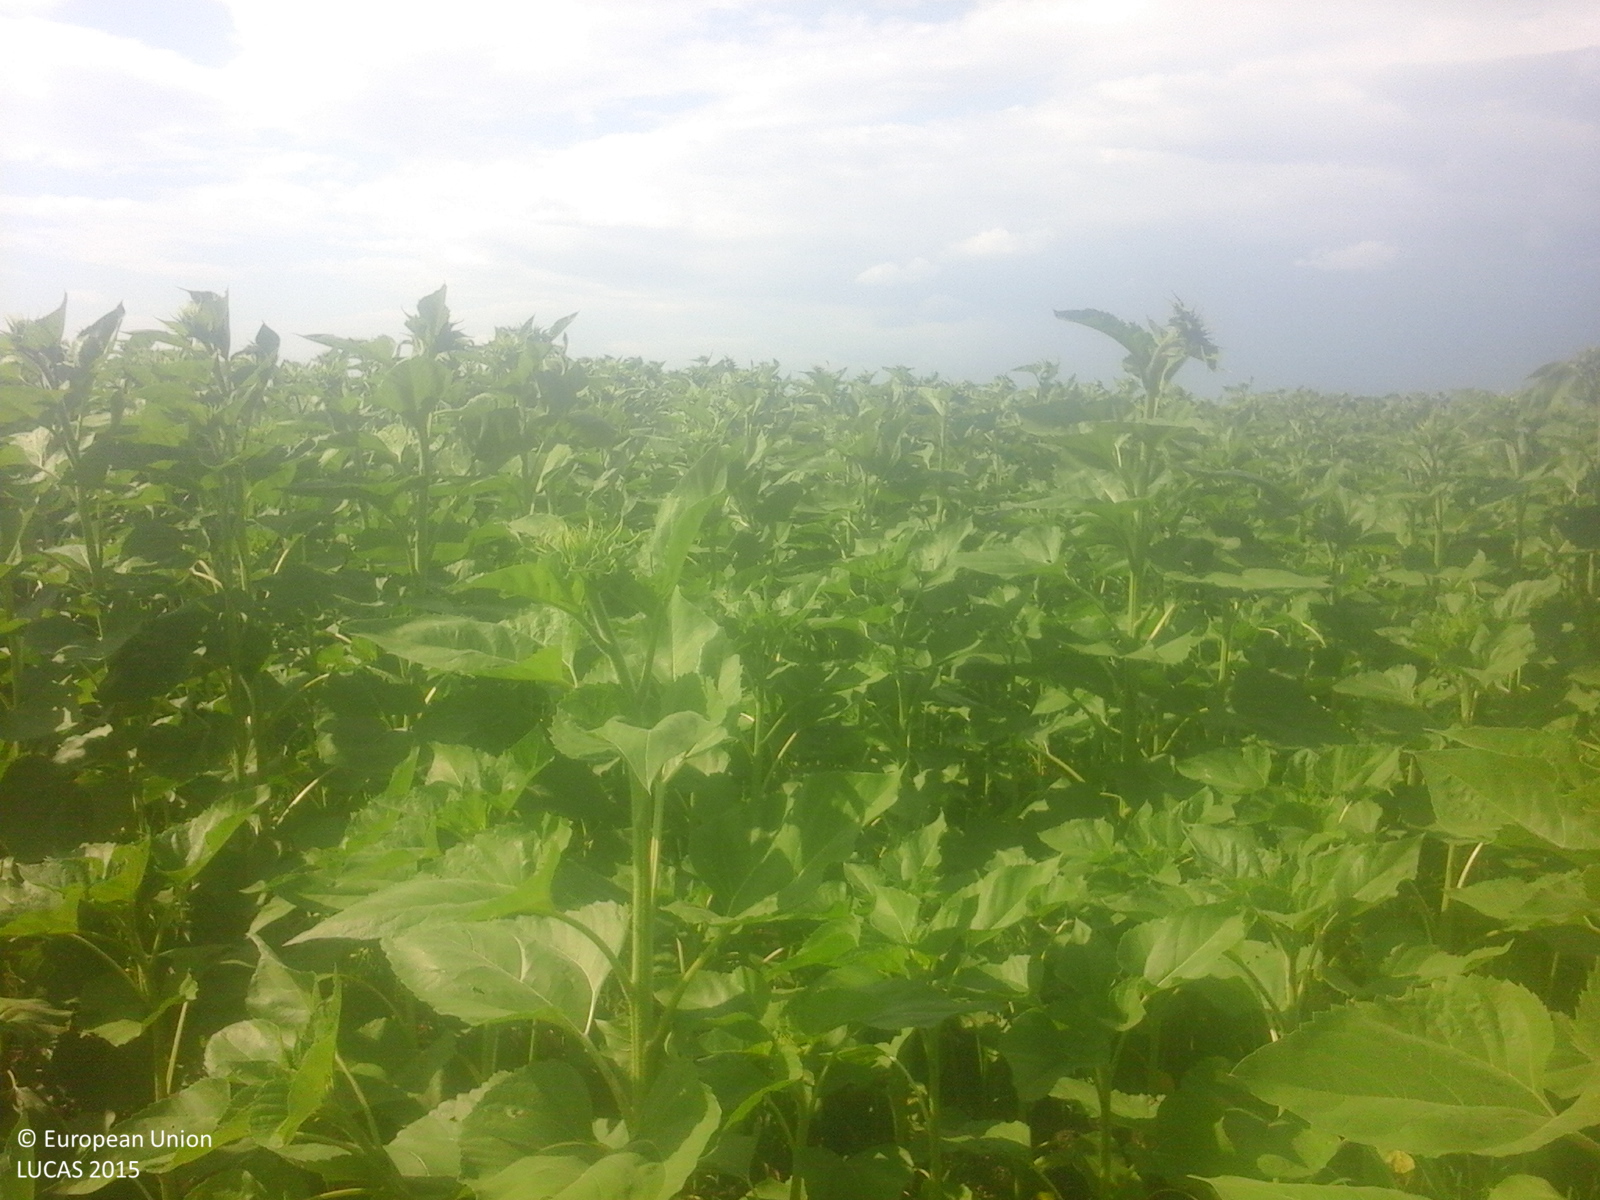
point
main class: Cropland
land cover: Sunflower
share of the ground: > 75 %
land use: Agriculture (excluding fallow land and kitchen gardens)
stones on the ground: < 10 %
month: July
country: RO
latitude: 44.0822
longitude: 25.4596
